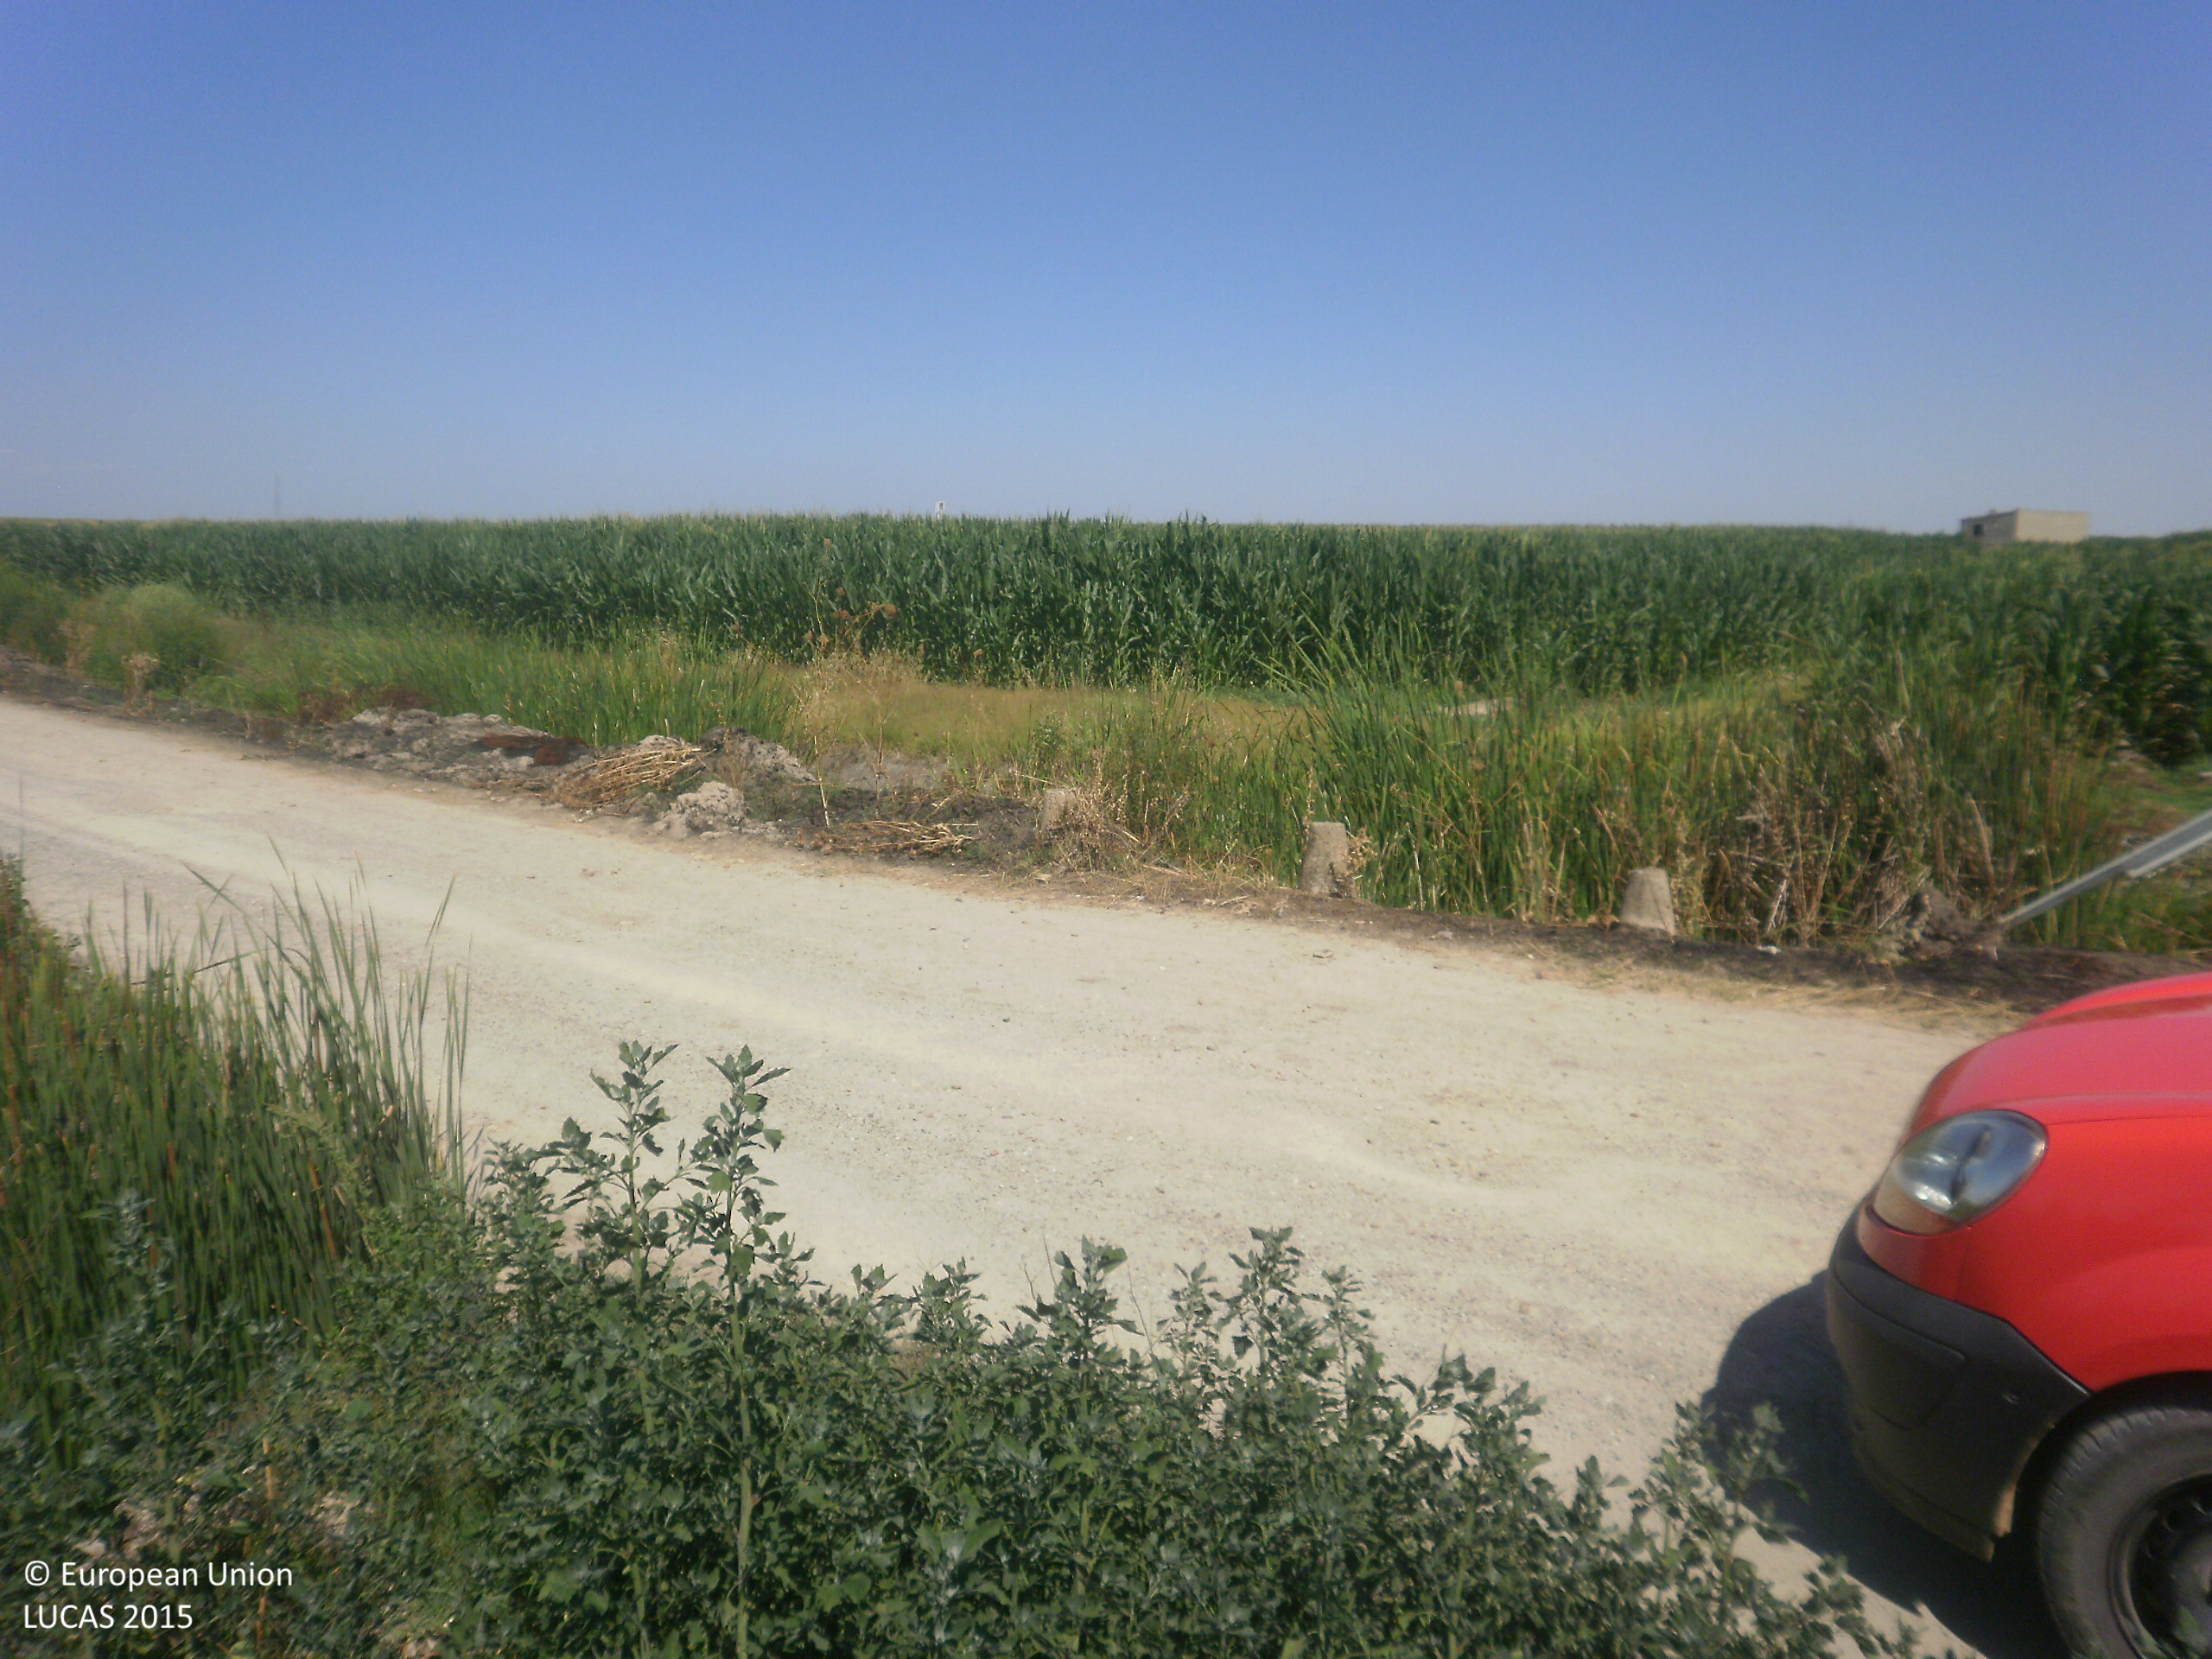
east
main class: Cropland
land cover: Maize
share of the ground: > 75 %
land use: Agriculture (excluding fallow land and kitchen gardens)
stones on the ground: < 10 %
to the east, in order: Maize; Ditches and canals; Tracks; Maize; Grass margins
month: June
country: ES
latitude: 39.0569
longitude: -5.9890
